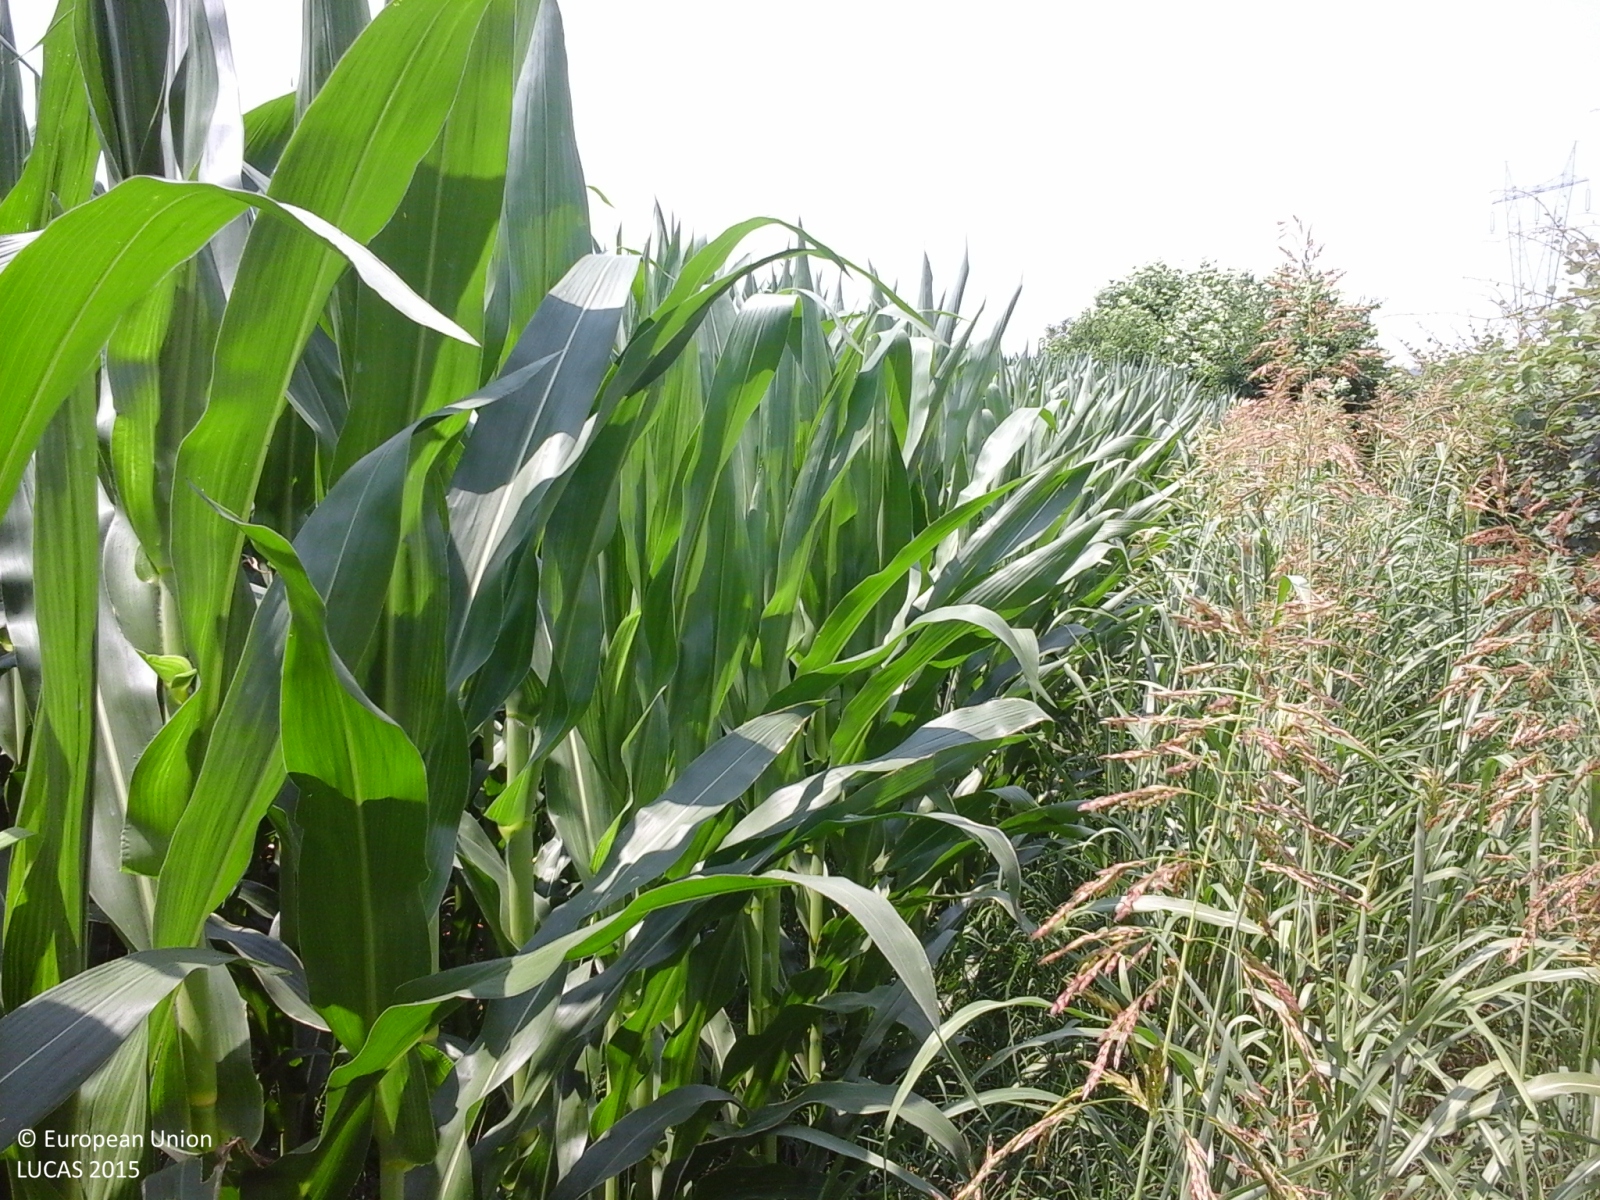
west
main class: Cropland
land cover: Maize
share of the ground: > 75 %
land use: Agriculture (excluding fallow land and kitchen gardens)
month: June
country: IT
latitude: 45.3572
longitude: 10.8028
